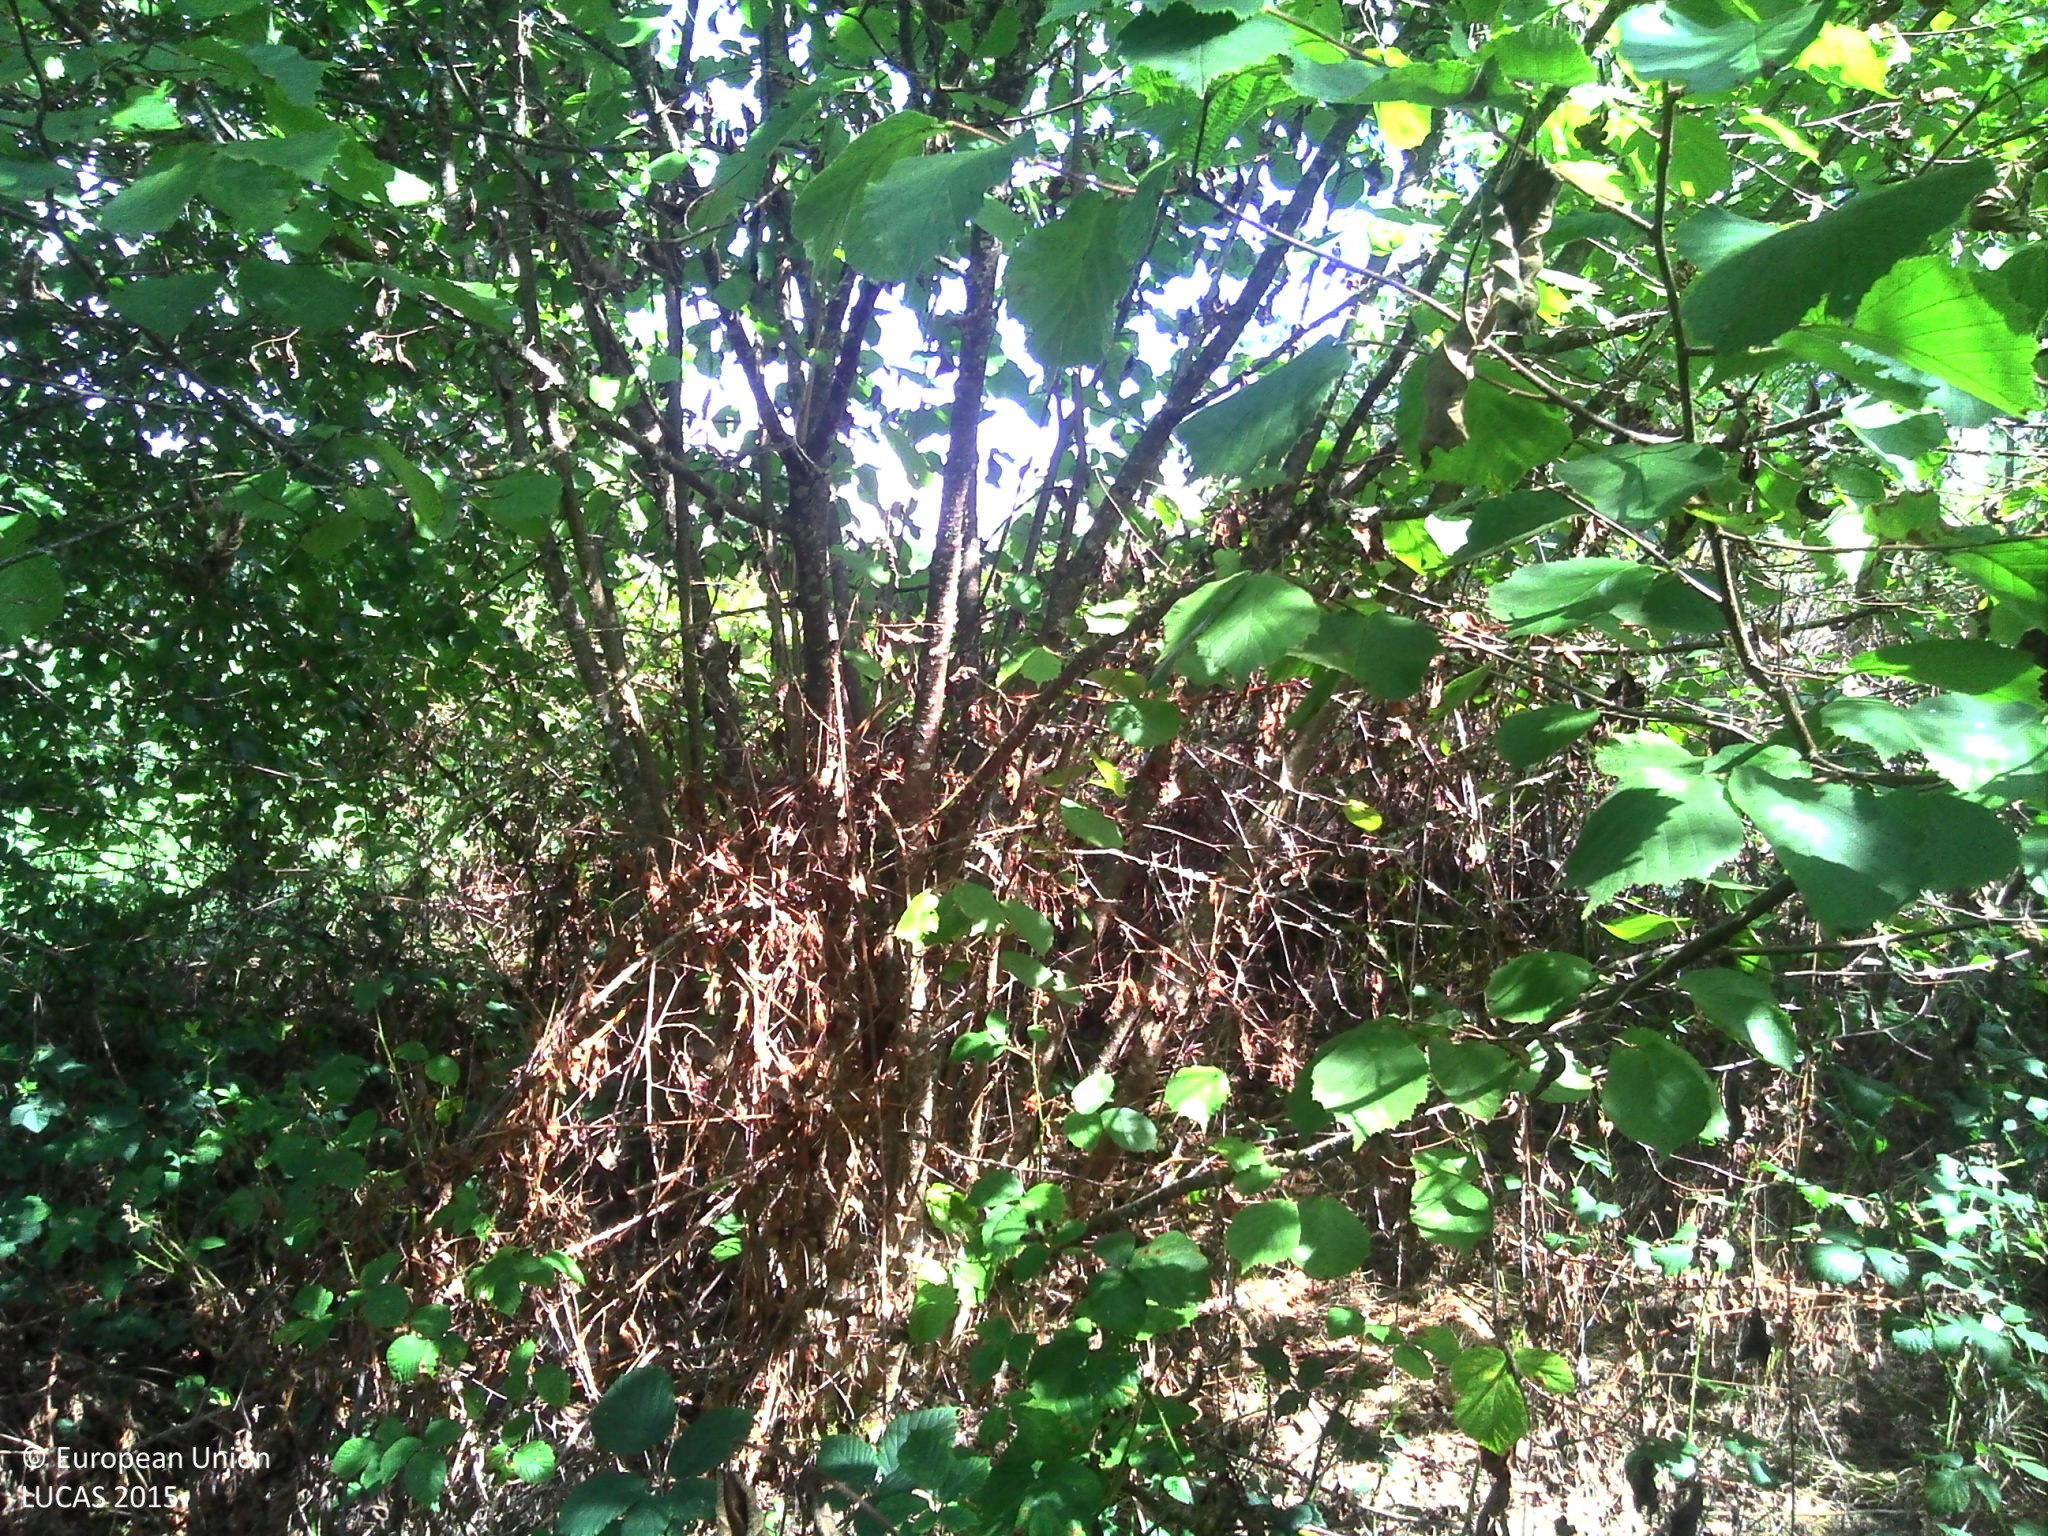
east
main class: Woodland
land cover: Spruce dominated mixed woodland
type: mesophytic deciduous forest
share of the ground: > 75 %
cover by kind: broadleaved forest trees 60 %, coniferous forest trees 25 %, shrubs 10 %, herbaceous plants 5 %
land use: Semi-natural and natural areas not in use
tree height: > 5 m
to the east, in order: Spruce dominated mixed woodland; Fences; Temporary grasslands; Fences; Managed hedges; Tracks; Dry stone walls; Fences; Lines of trees; Grassland without tree/shrub cover; Electric lines; Grassland without tree/shrub cover
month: August
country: FR
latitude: 45.7889
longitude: 2.3688
